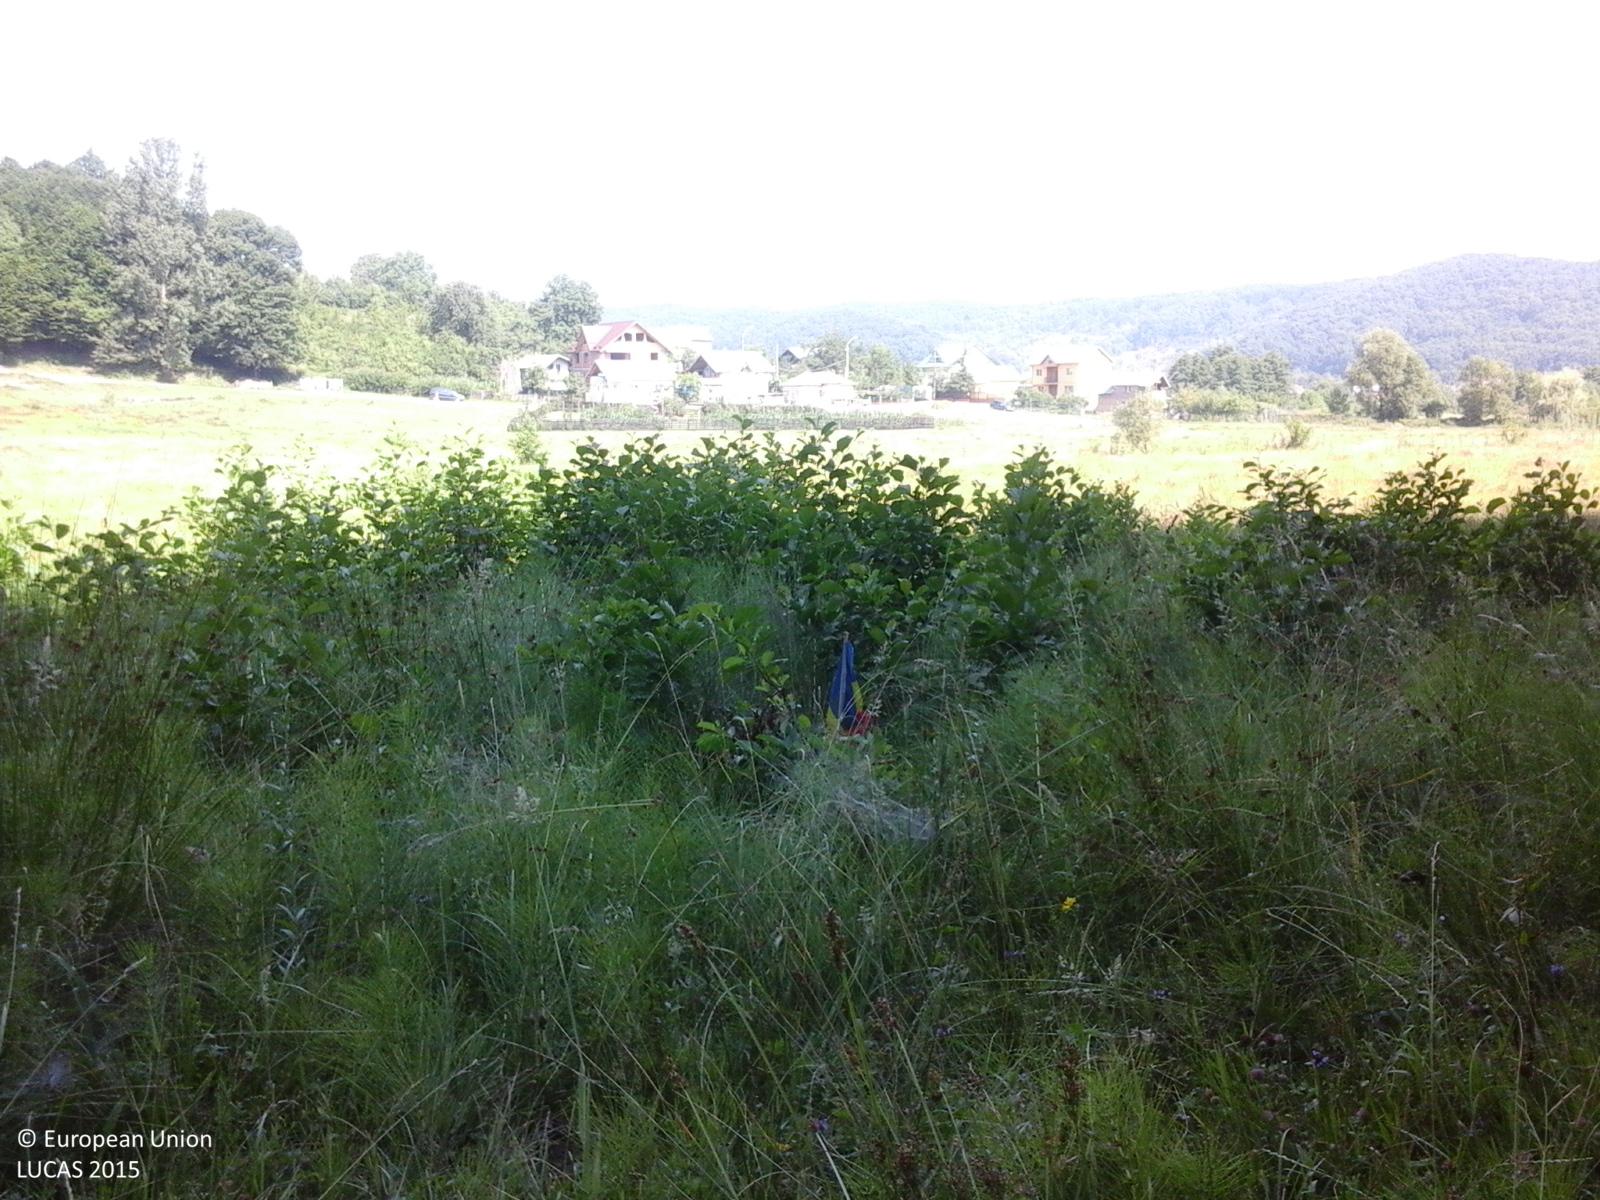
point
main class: Grassland
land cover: Grassland with sparse tree/shrub cover
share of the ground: > 75 %
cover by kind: herbaceous plants 90 %, broadleaved forest trees 5 %, shrubs 5 %
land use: Forestry
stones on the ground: 10 - 25 %
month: July
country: RO
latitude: 44.8786
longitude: 24.7772
